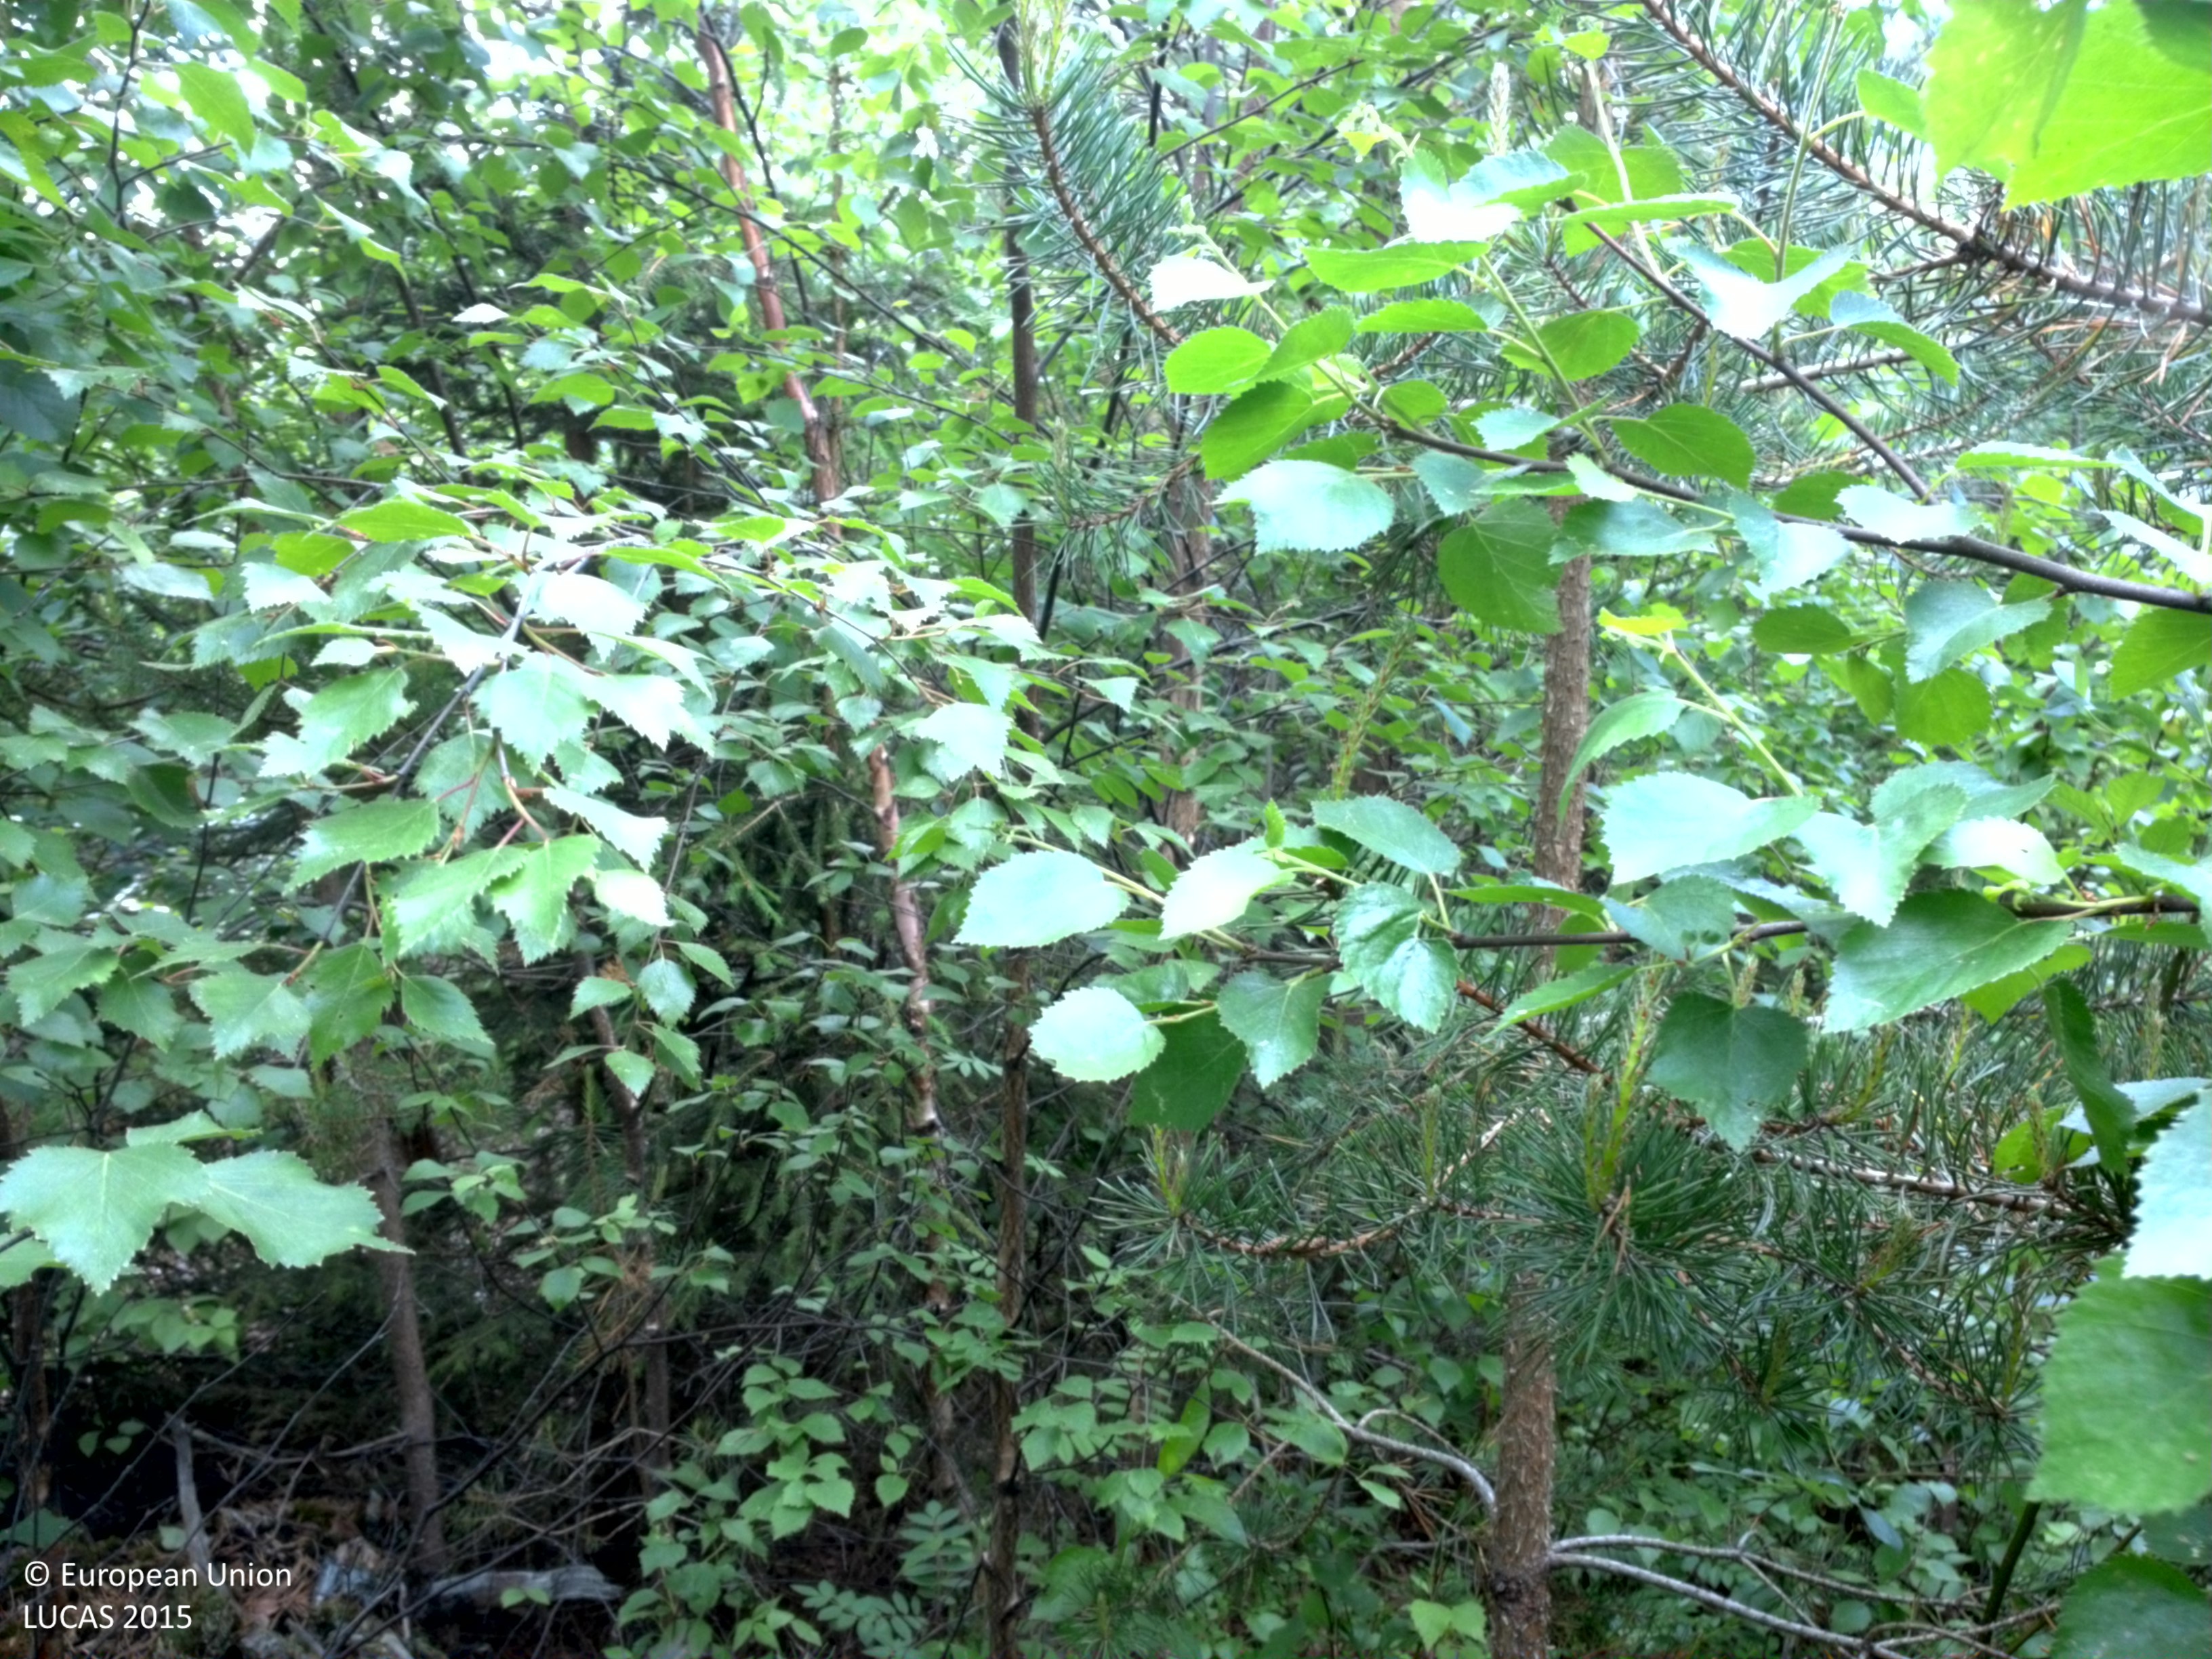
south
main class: Woodland
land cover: Pine dominated mixed woodland
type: boreal forest
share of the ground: > 75 %
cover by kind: broadleaved forest trees 60 %, coniferous forest trees 20 %, herbaceous plants 15 %, shrubs 5 %
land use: Forestry
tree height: < 5 m
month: July
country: SE
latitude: 64.3211
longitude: 20.7985
